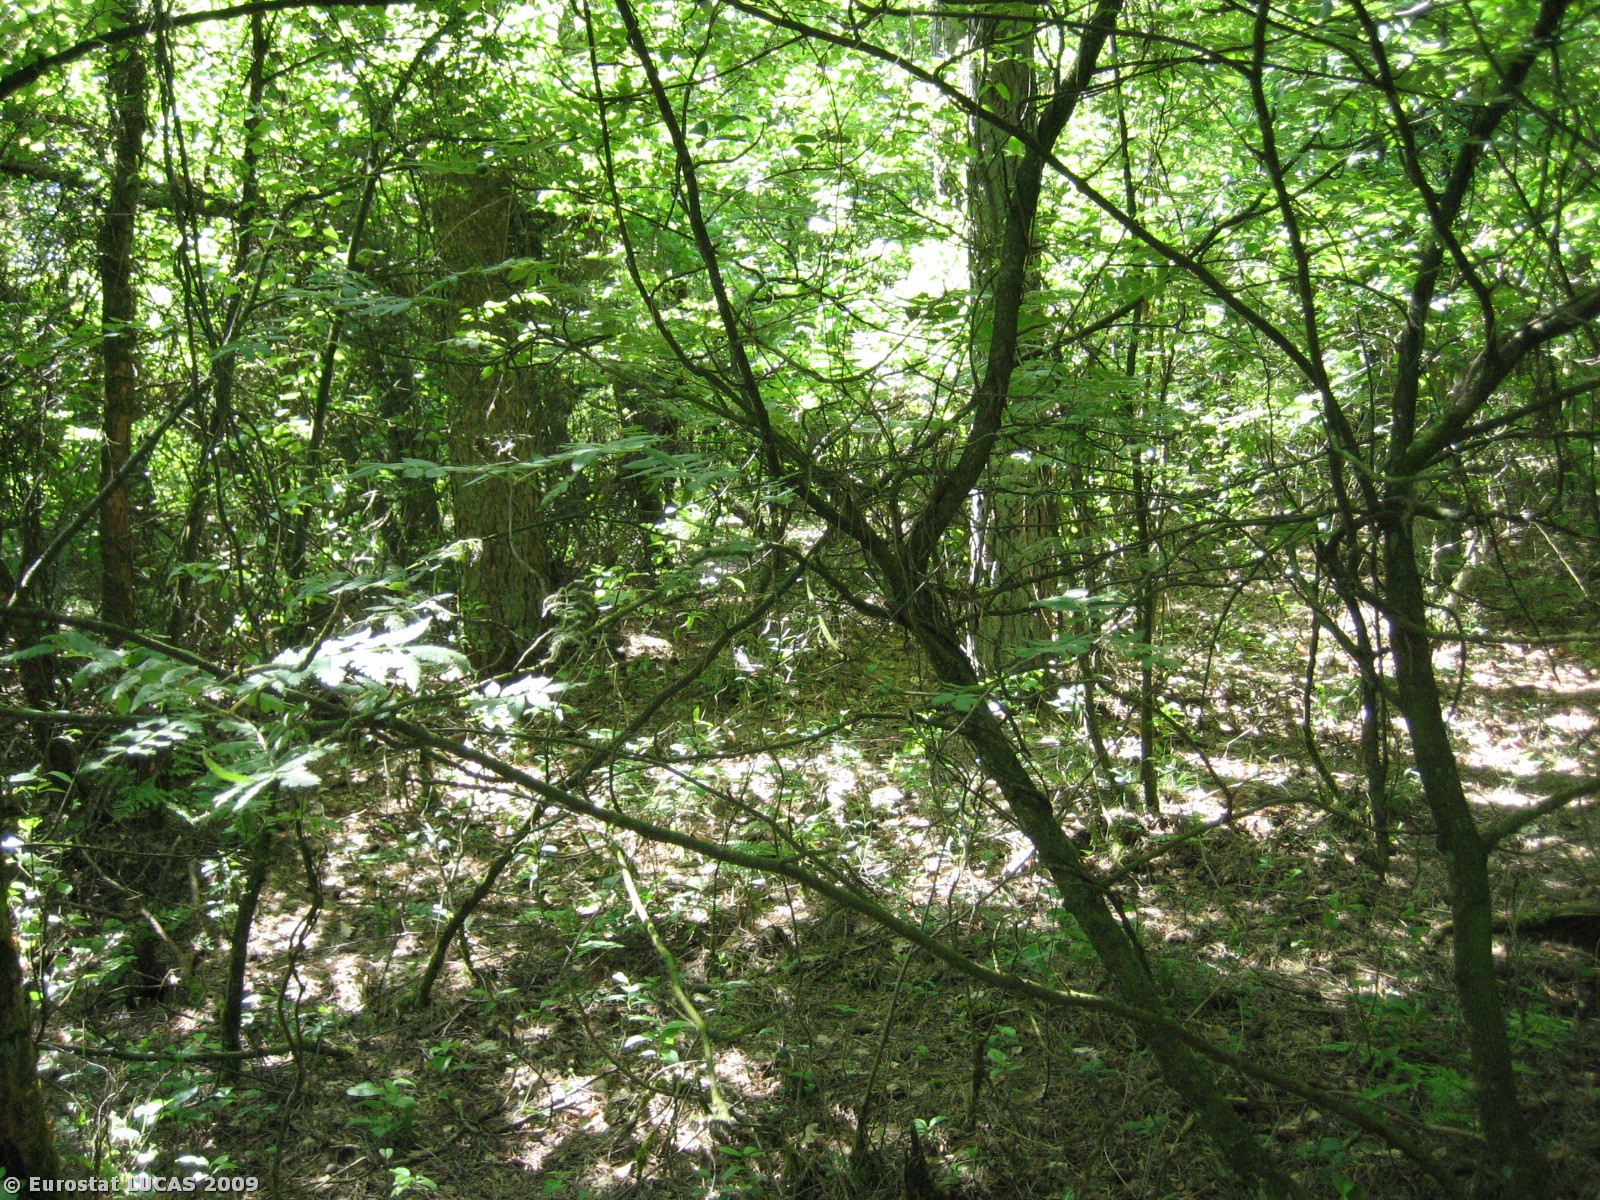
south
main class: Woodland
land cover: Mixed woodland
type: mesophytic deciduous forest
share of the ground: > 75 %
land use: Unused
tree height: > 5 m
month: May
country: DK
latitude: 55.9139
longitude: 8.9612
